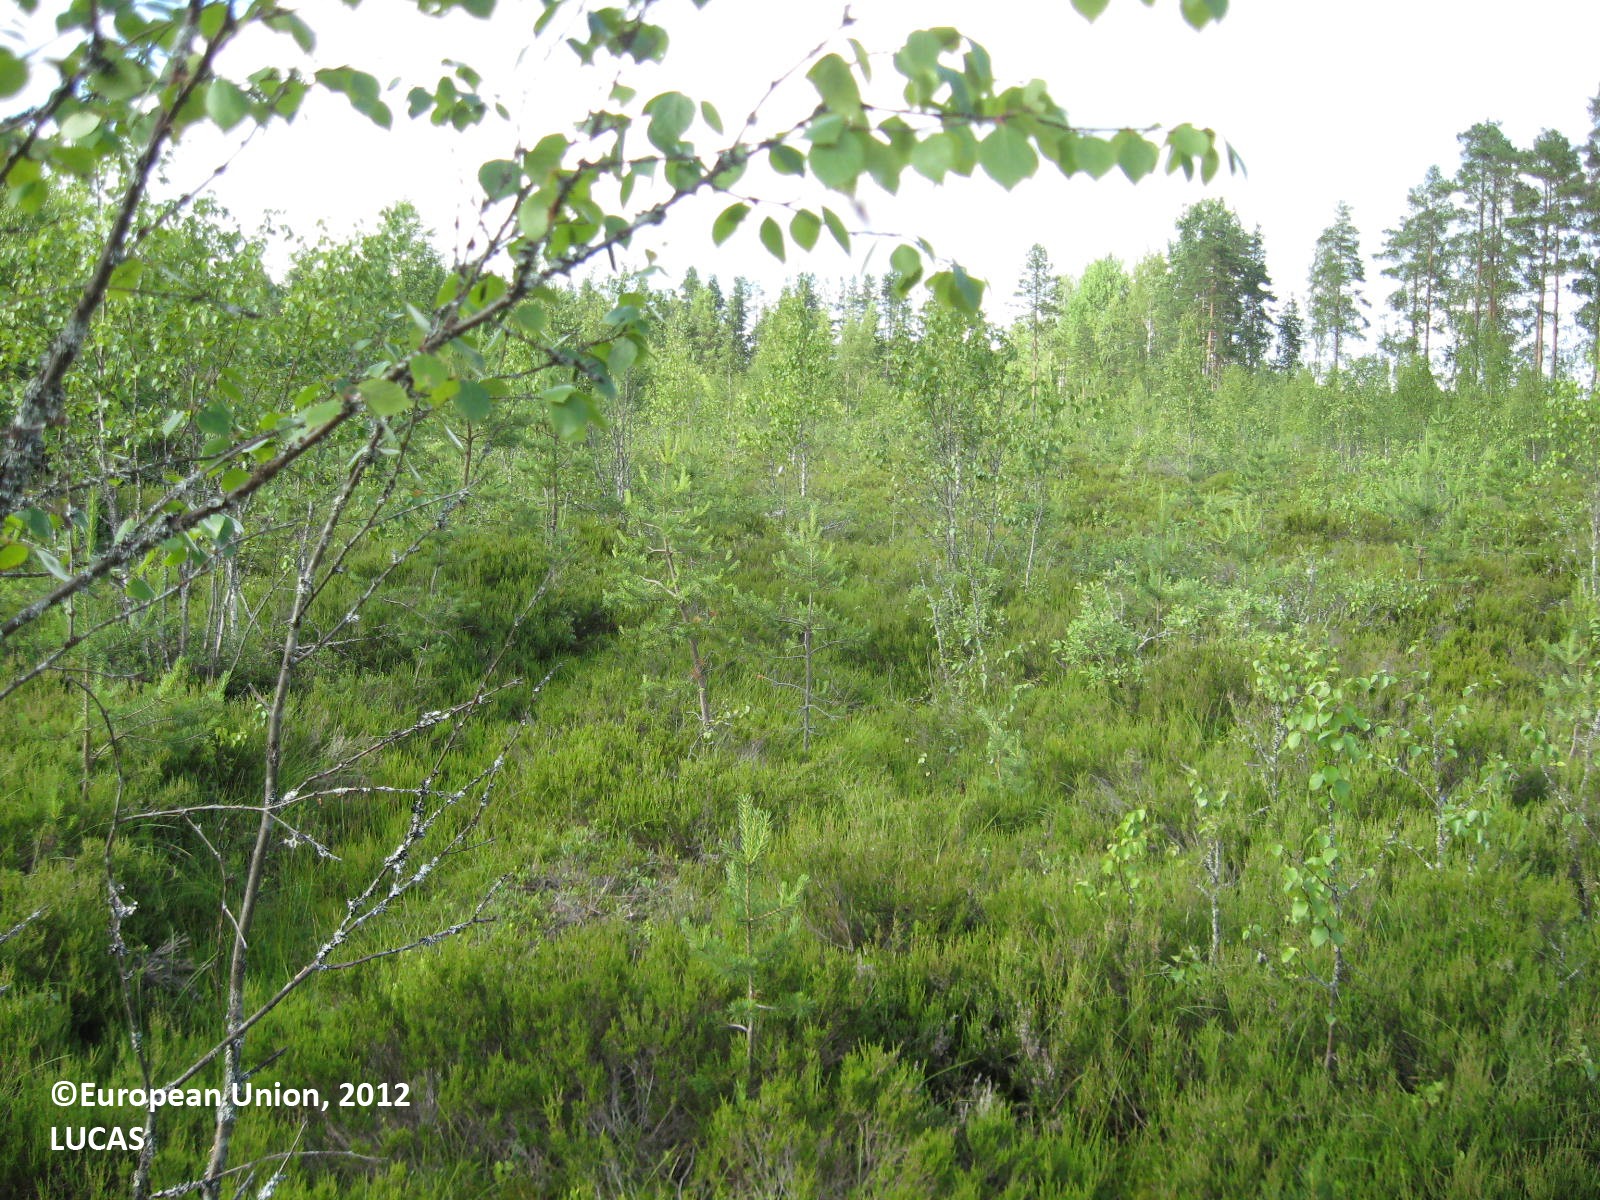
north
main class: Woodland
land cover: Other mixed woodland
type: boreal forest
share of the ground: 25 - 50 %
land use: Forestry
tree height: < 5 m
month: July
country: FI
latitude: 62.2750
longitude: 22.6804
